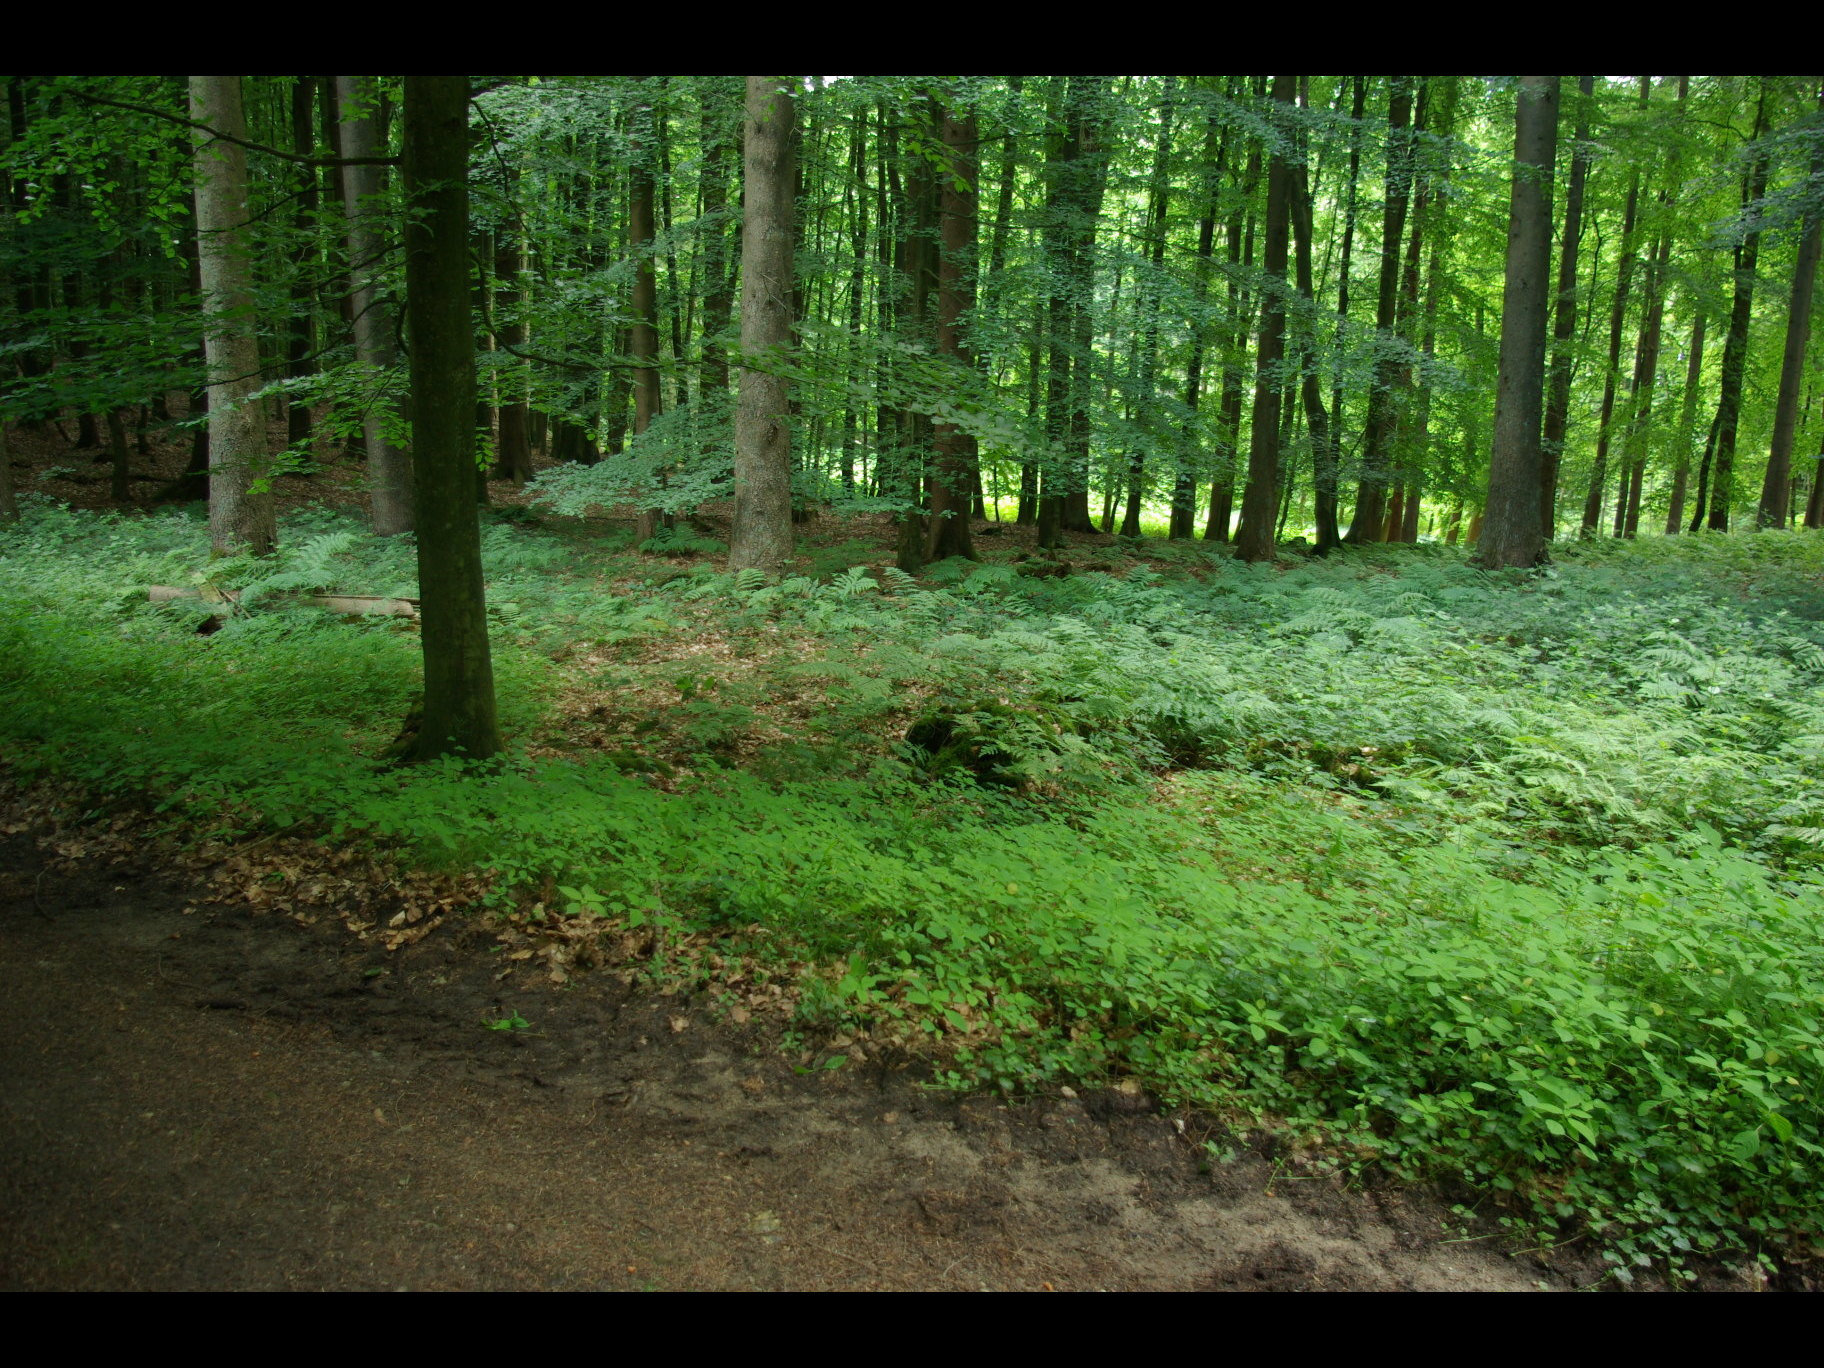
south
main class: Woodland
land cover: Other mixed woodland
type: hemiboreal forest and nemoral coniferous forest and mixed broadleaved-coniferous forest
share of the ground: > 75 %
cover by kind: coniferous forest trees 45 %, broadleaved forest trees 45 %, herbaceous plants 5 %, unconsolidated bare surface 5 %
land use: Forestry
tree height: > 5 m
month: June
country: DE
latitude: 54.3005
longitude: 9.8925
